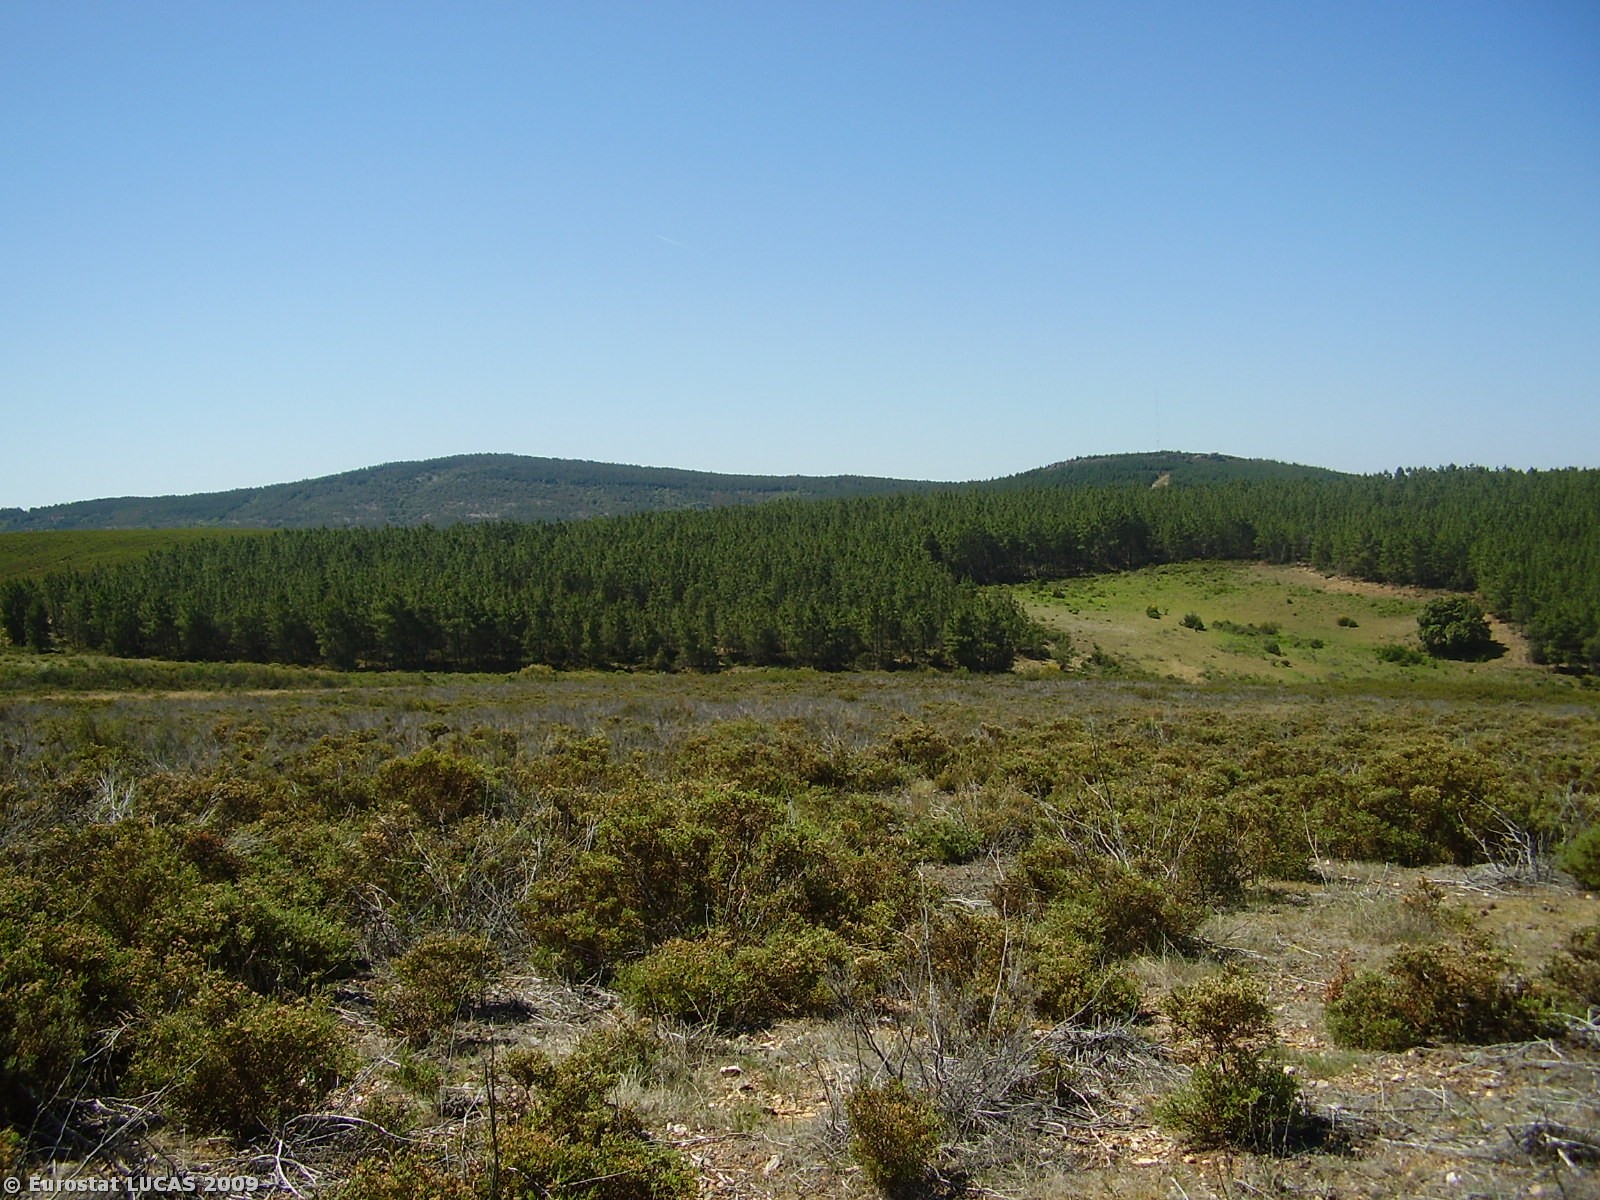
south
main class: Shrubland
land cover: Shrubland without tree cover
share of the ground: 50 - 75 %
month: June
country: PT
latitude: 41.9181
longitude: -6.5933
